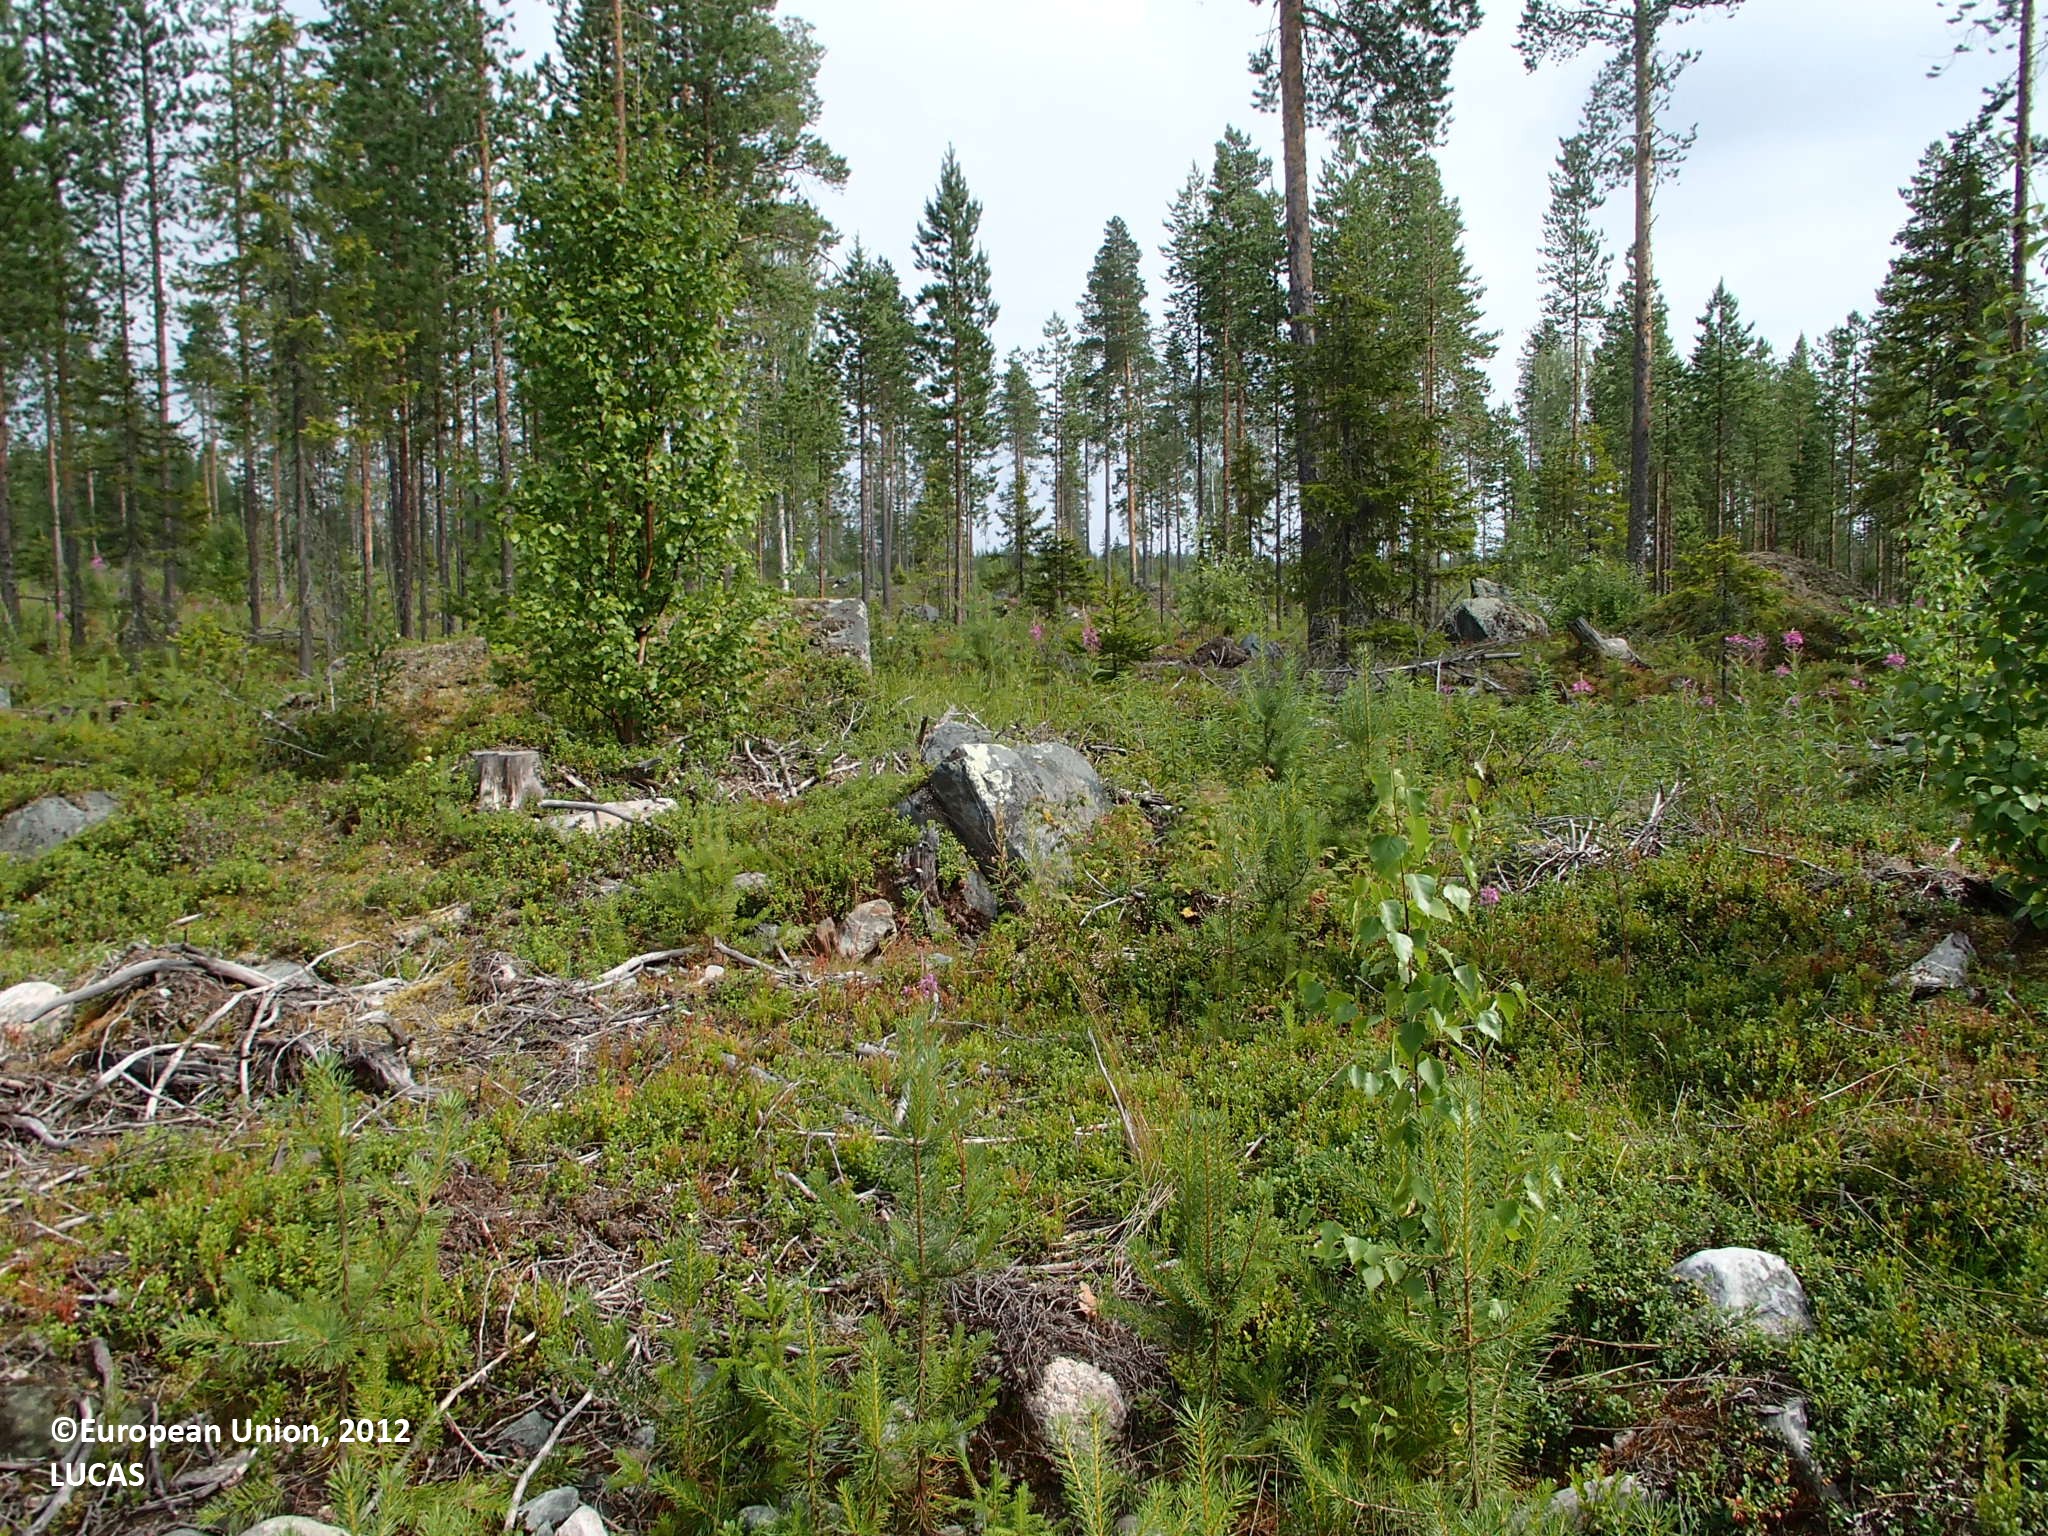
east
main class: Woodland
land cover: Pine dominated coniferous woodland
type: boreal forest
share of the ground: 10 - 25 %
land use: Forestry
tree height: > 5 m
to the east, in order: Pine dominated coniferous woodland; Other coniferous woodland
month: July
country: FI
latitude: 66.1965
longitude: 25.3639
